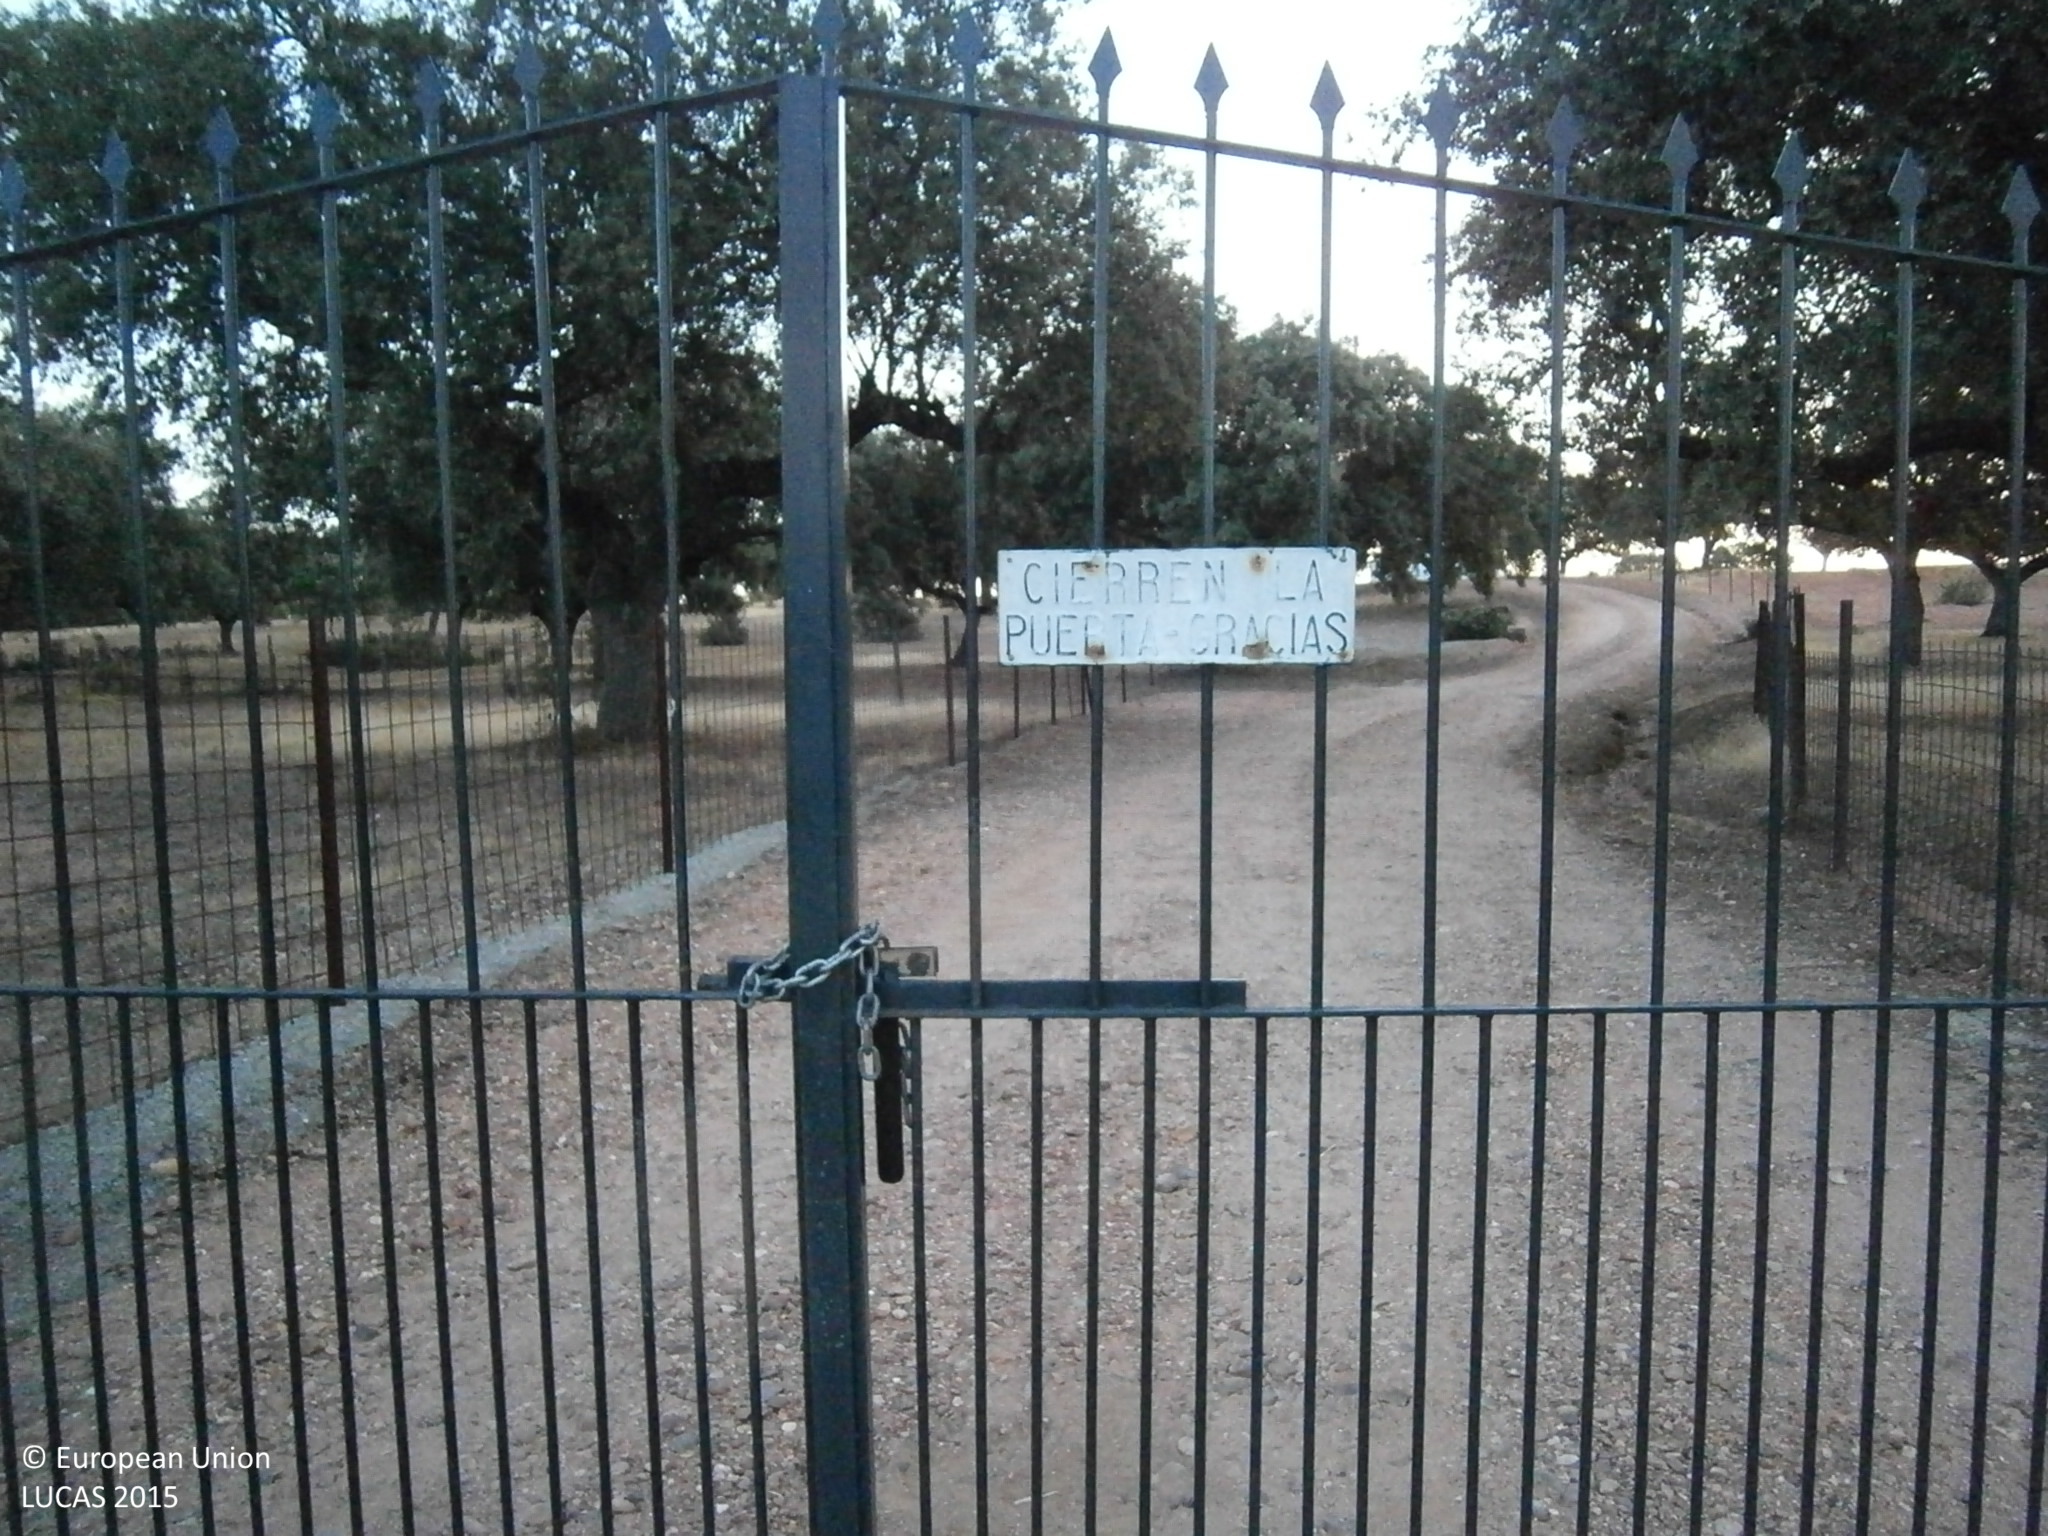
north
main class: Woodland
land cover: Broadleaved woodland
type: broadleaved evergreen forest
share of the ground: > 75 %
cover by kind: broadleaved forest trees 90 %, shrubs 5 %, unconsolidated bare surface 5 %
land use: Forestry
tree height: > 5 m
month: July
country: ES
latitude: 38.8348
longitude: -6.8510
